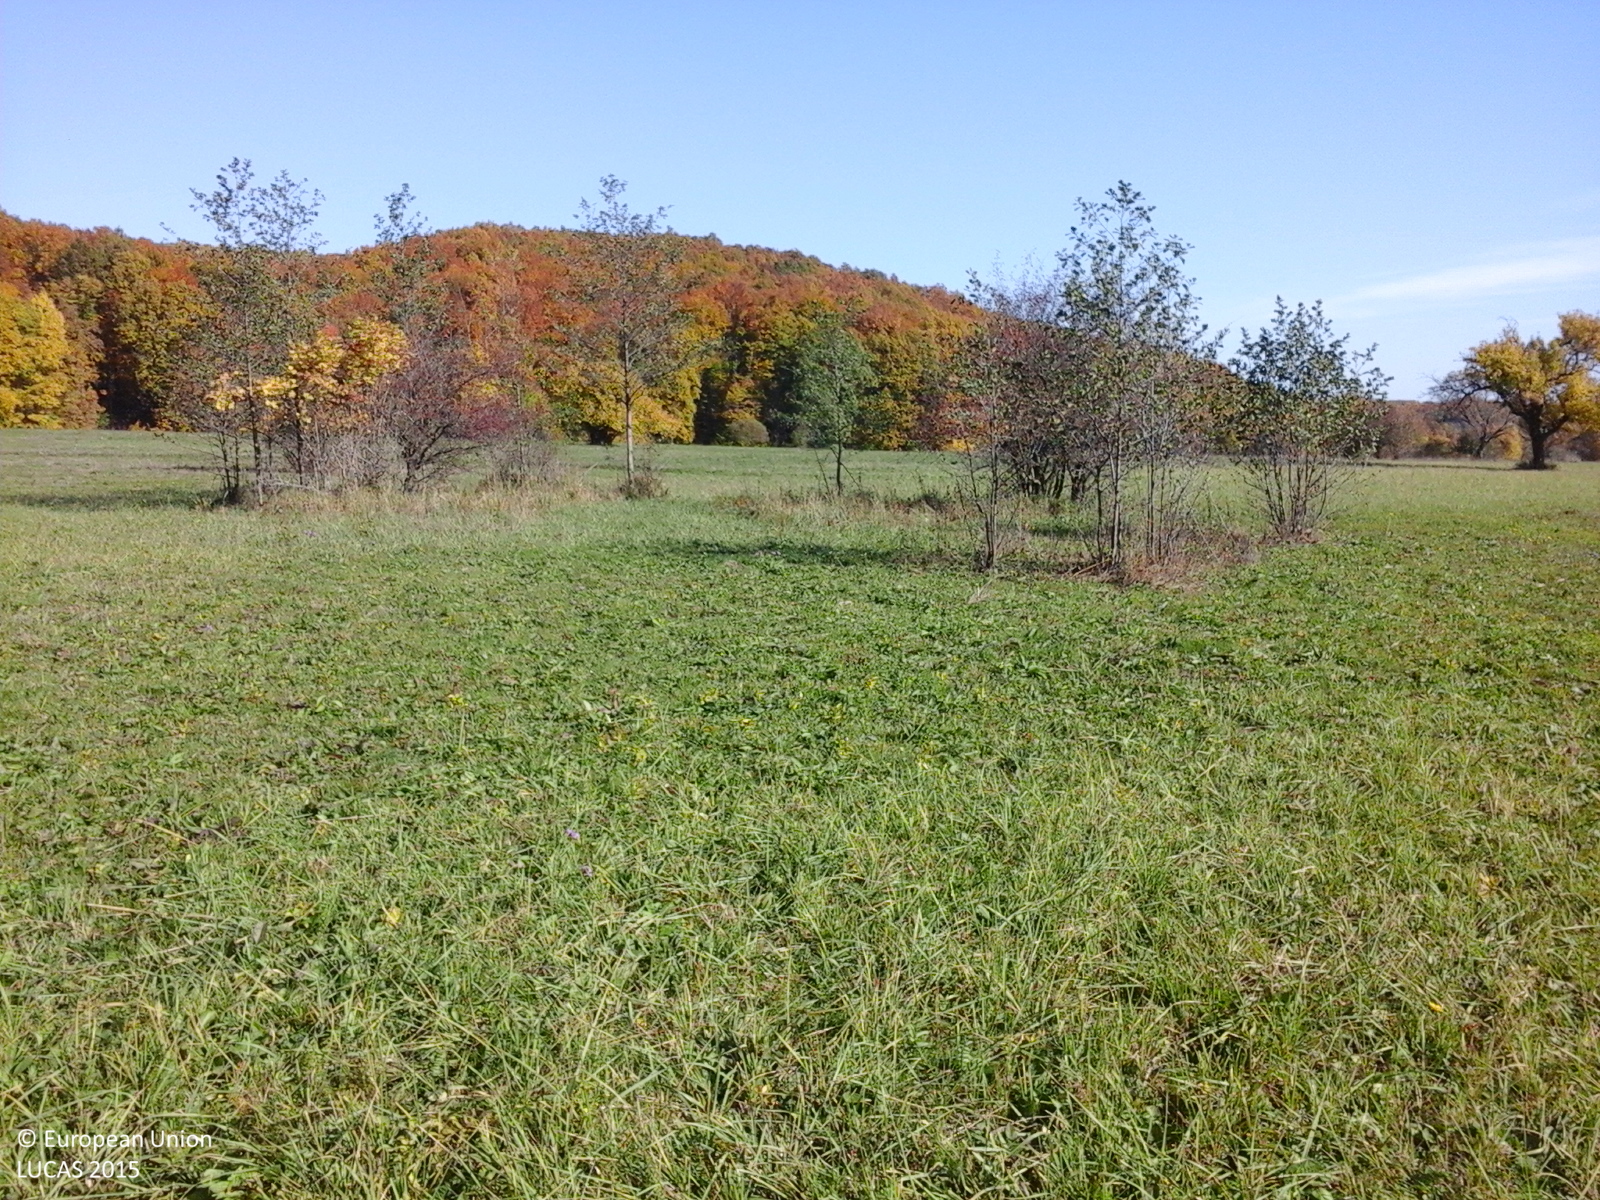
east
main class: Grassland
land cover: Grassland without tree/shrub cover
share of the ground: > 75 %
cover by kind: herbaceous plants 100 %
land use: Agriculture (excluding fallow land and kitchen gardens)
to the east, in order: Grassland without tree/shrub cover; Grassland with sparse tree/shrub cover; Grassland without tree/shrub cover; Tracks; Abandoned hedges; Grassland without tree/shrub cover; Tracks; Grassland without tree/shrub cover
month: October
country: RO
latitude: 46.0511
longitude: 26.9575
